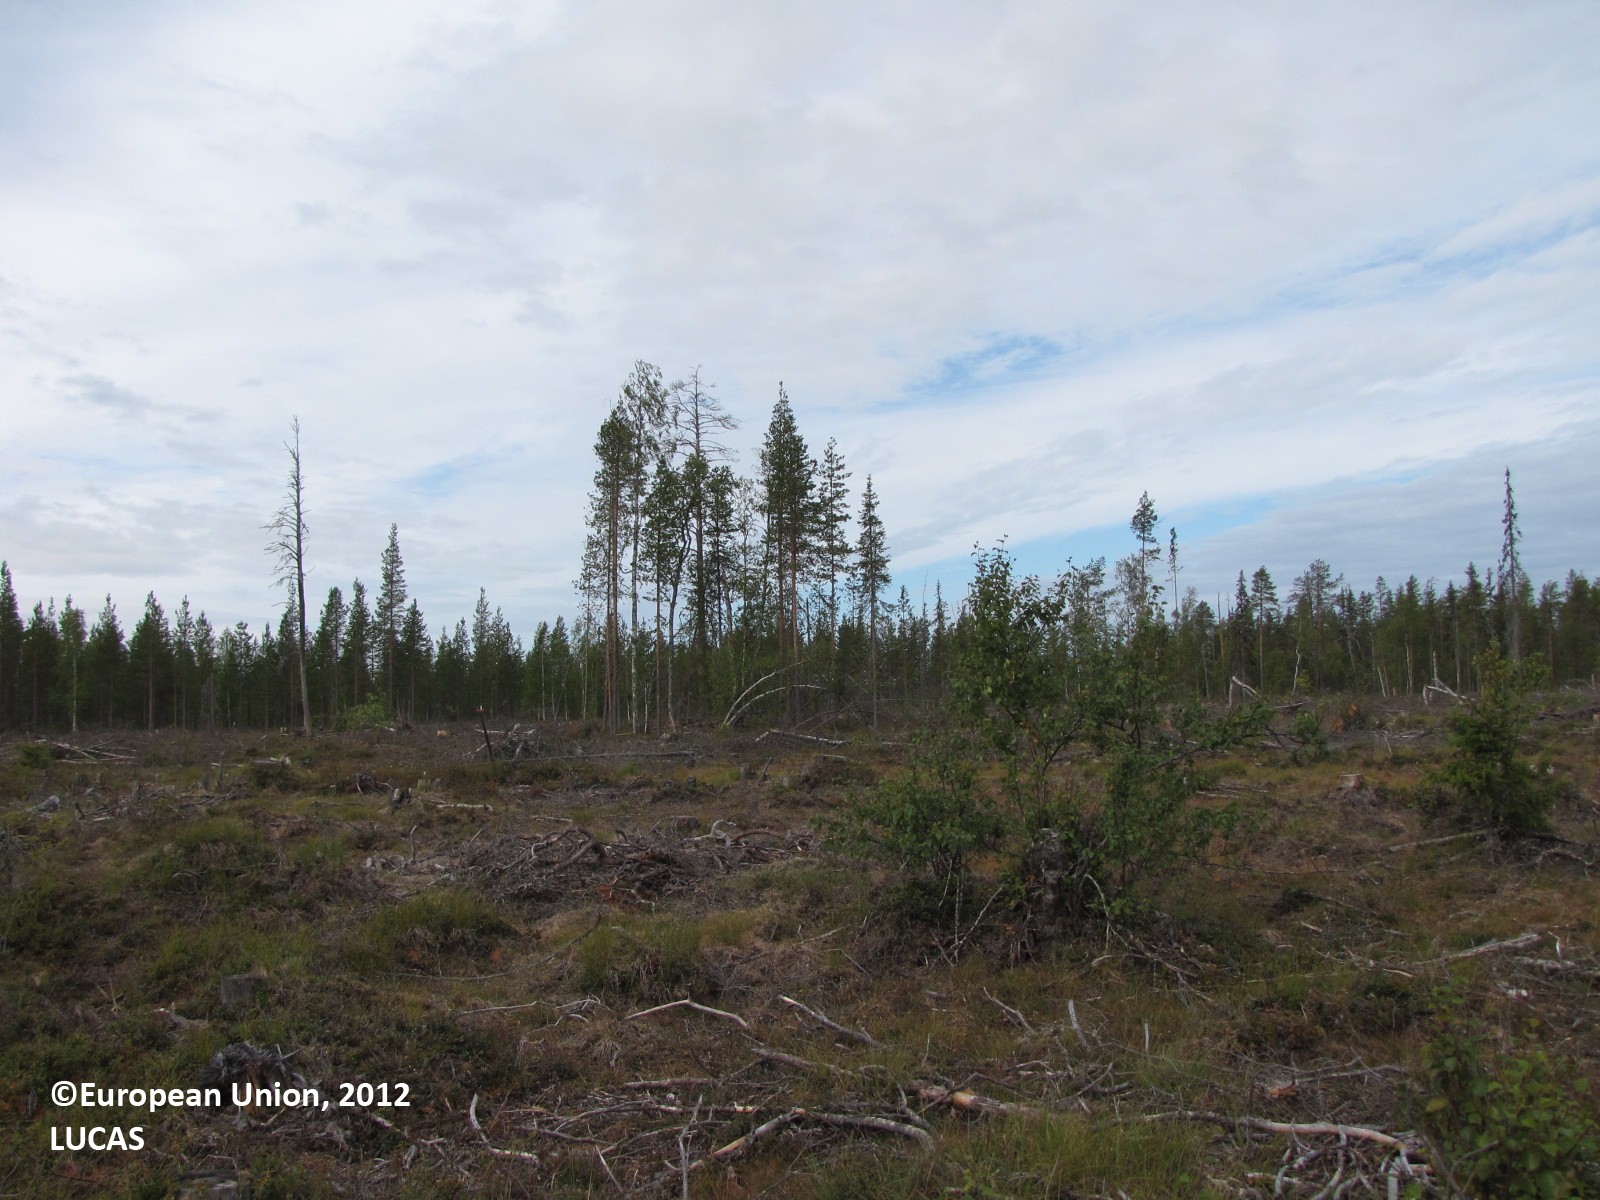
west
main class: Shrubland
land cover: Shrubland with sparse tree cover
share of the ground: > 75 %
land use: Energy production
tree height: < 5 m
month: August
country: FI
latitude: 67.1107
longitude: 25.0917
